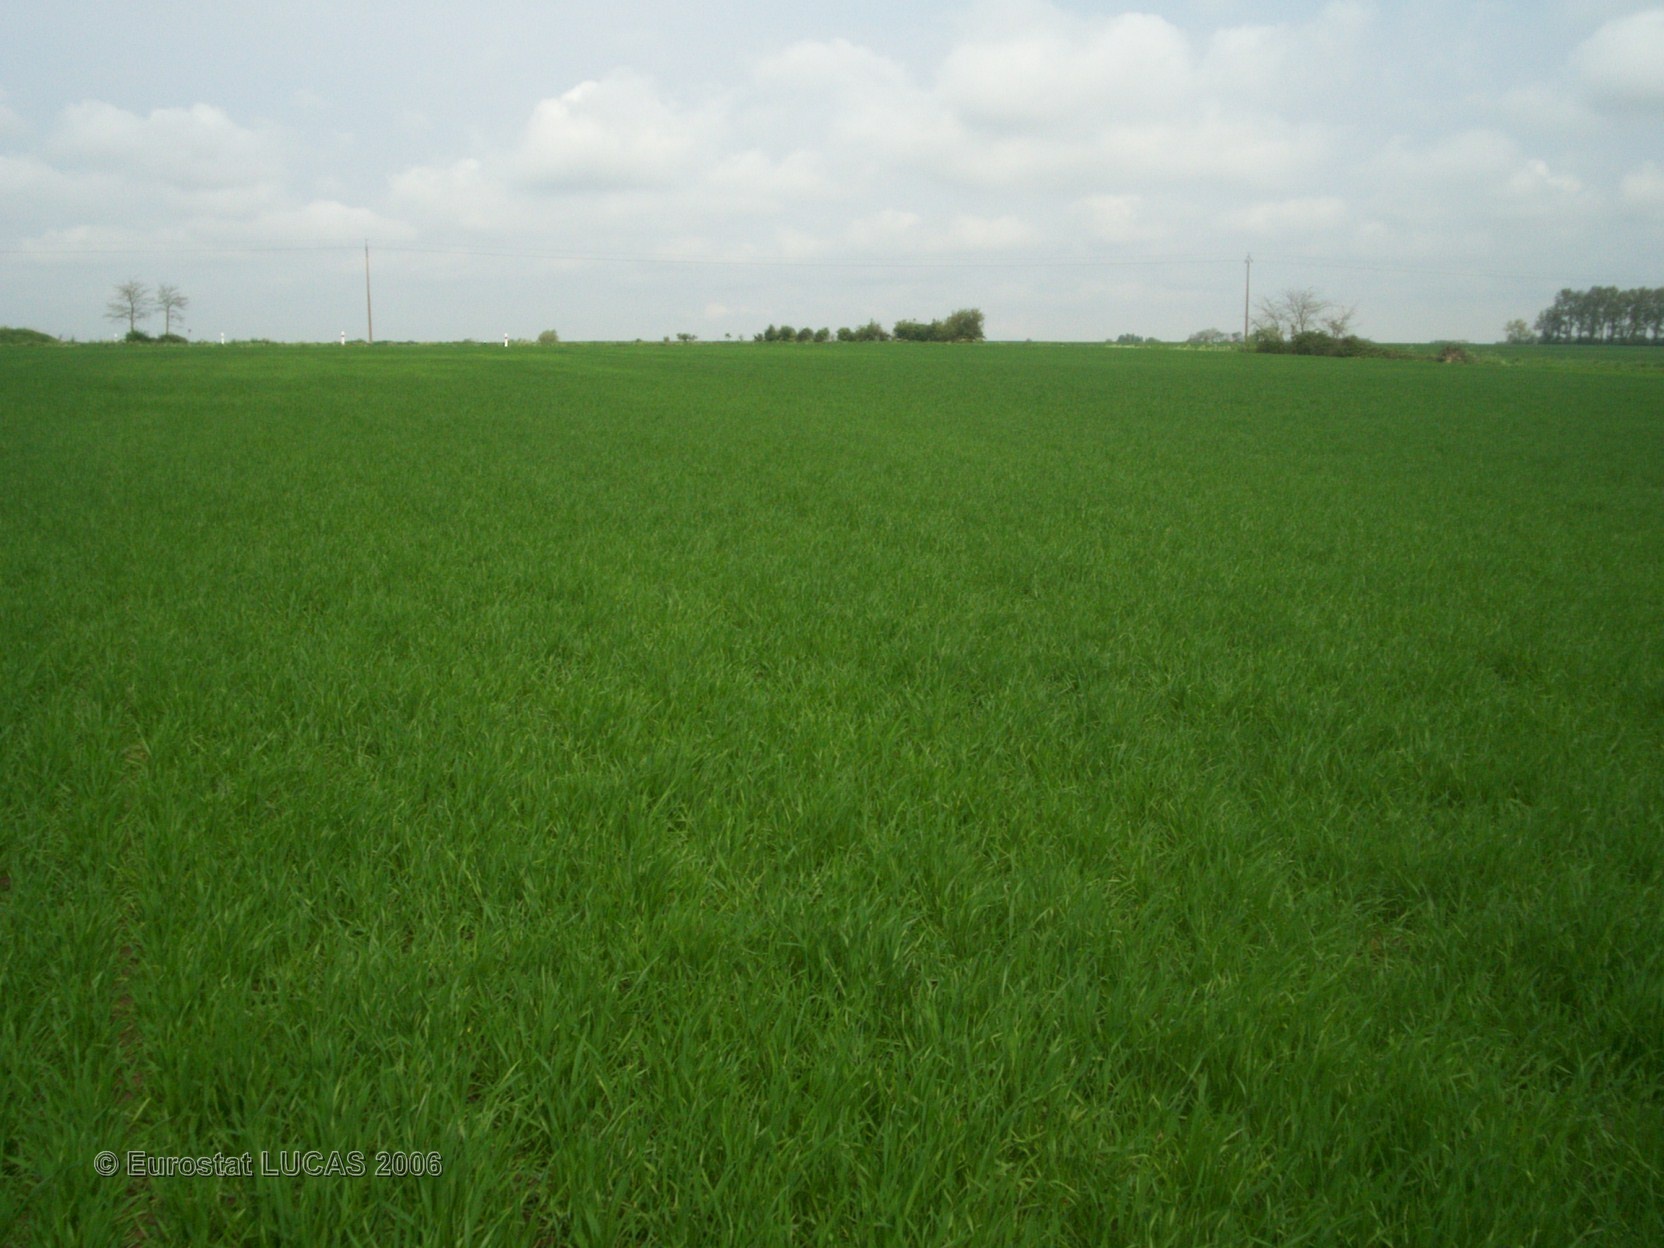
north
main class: Cropland
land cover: Common wheat
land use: Agriculture (excluding fallow land and kitchen gardens)
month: May
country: FR
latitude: 50.8987
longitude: 2.2937
